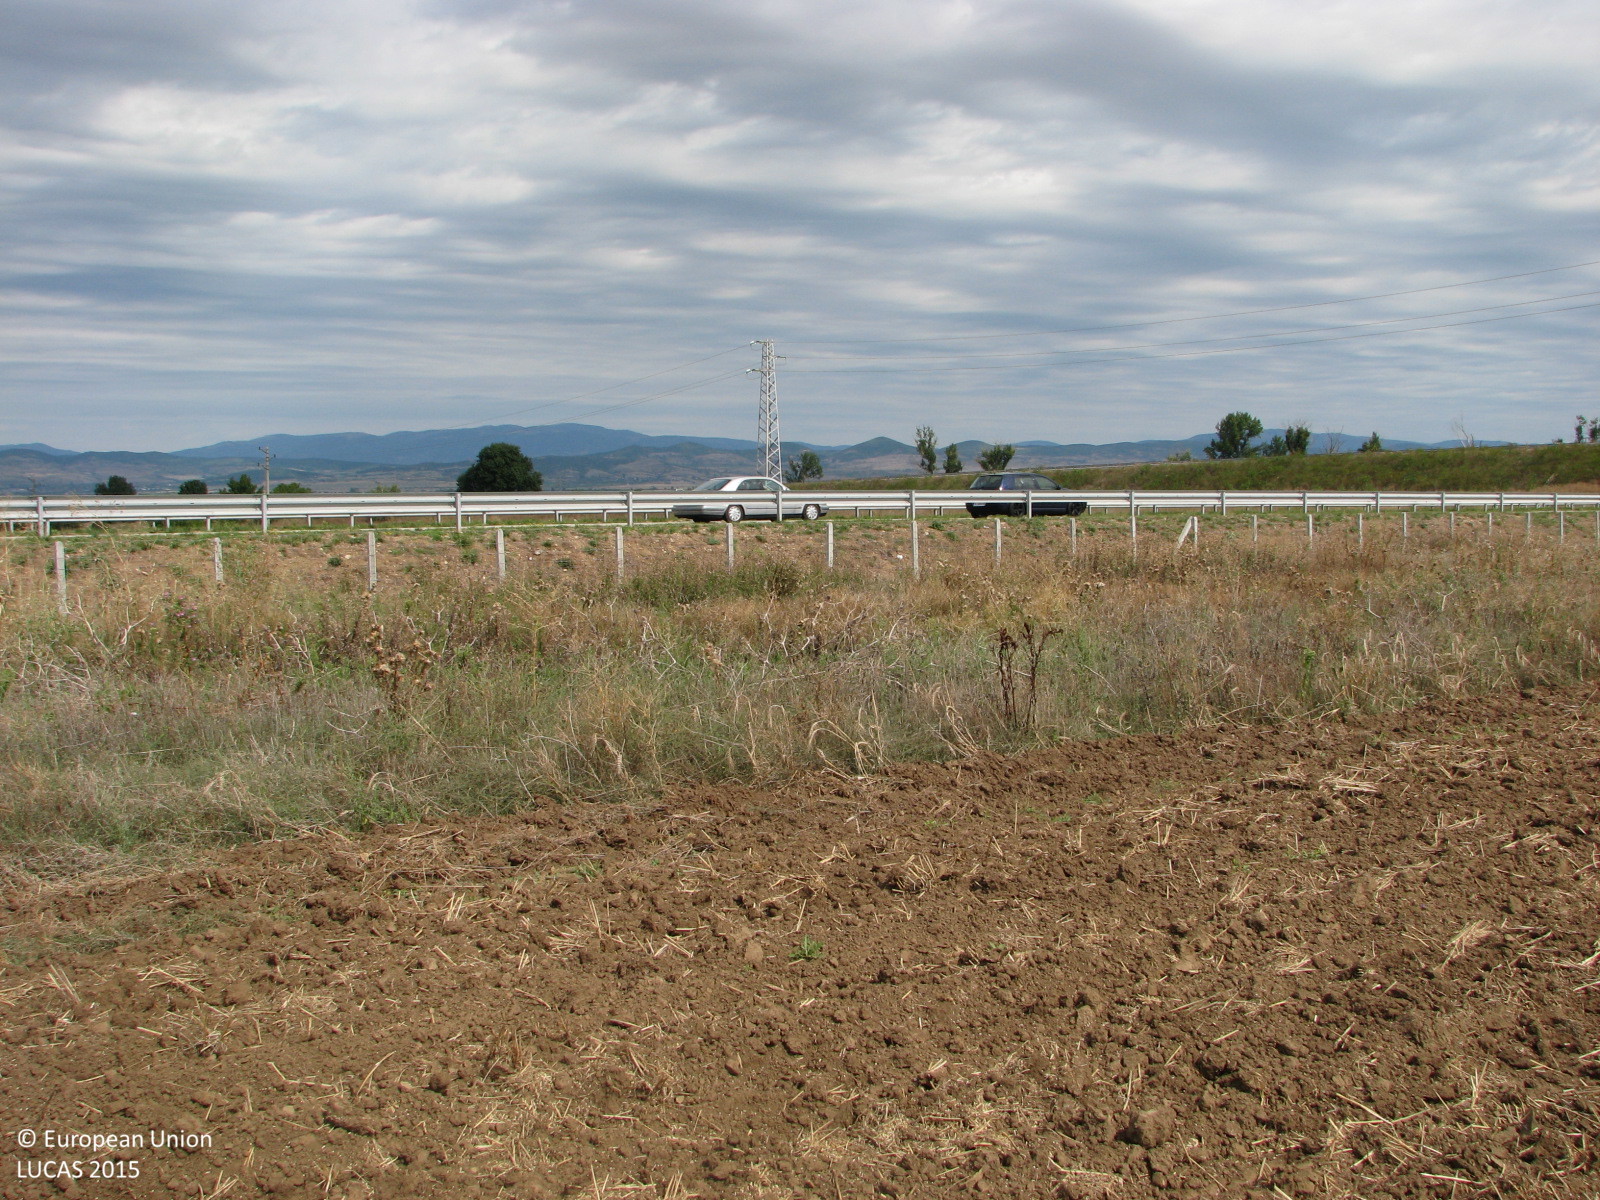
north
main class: Cropland
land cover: Common wheat
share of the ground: < 10 %
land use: Agriculture (excluding fallow land and kitchen gardens)
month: September
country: BG
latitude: 42.4492
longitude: 26.0455
